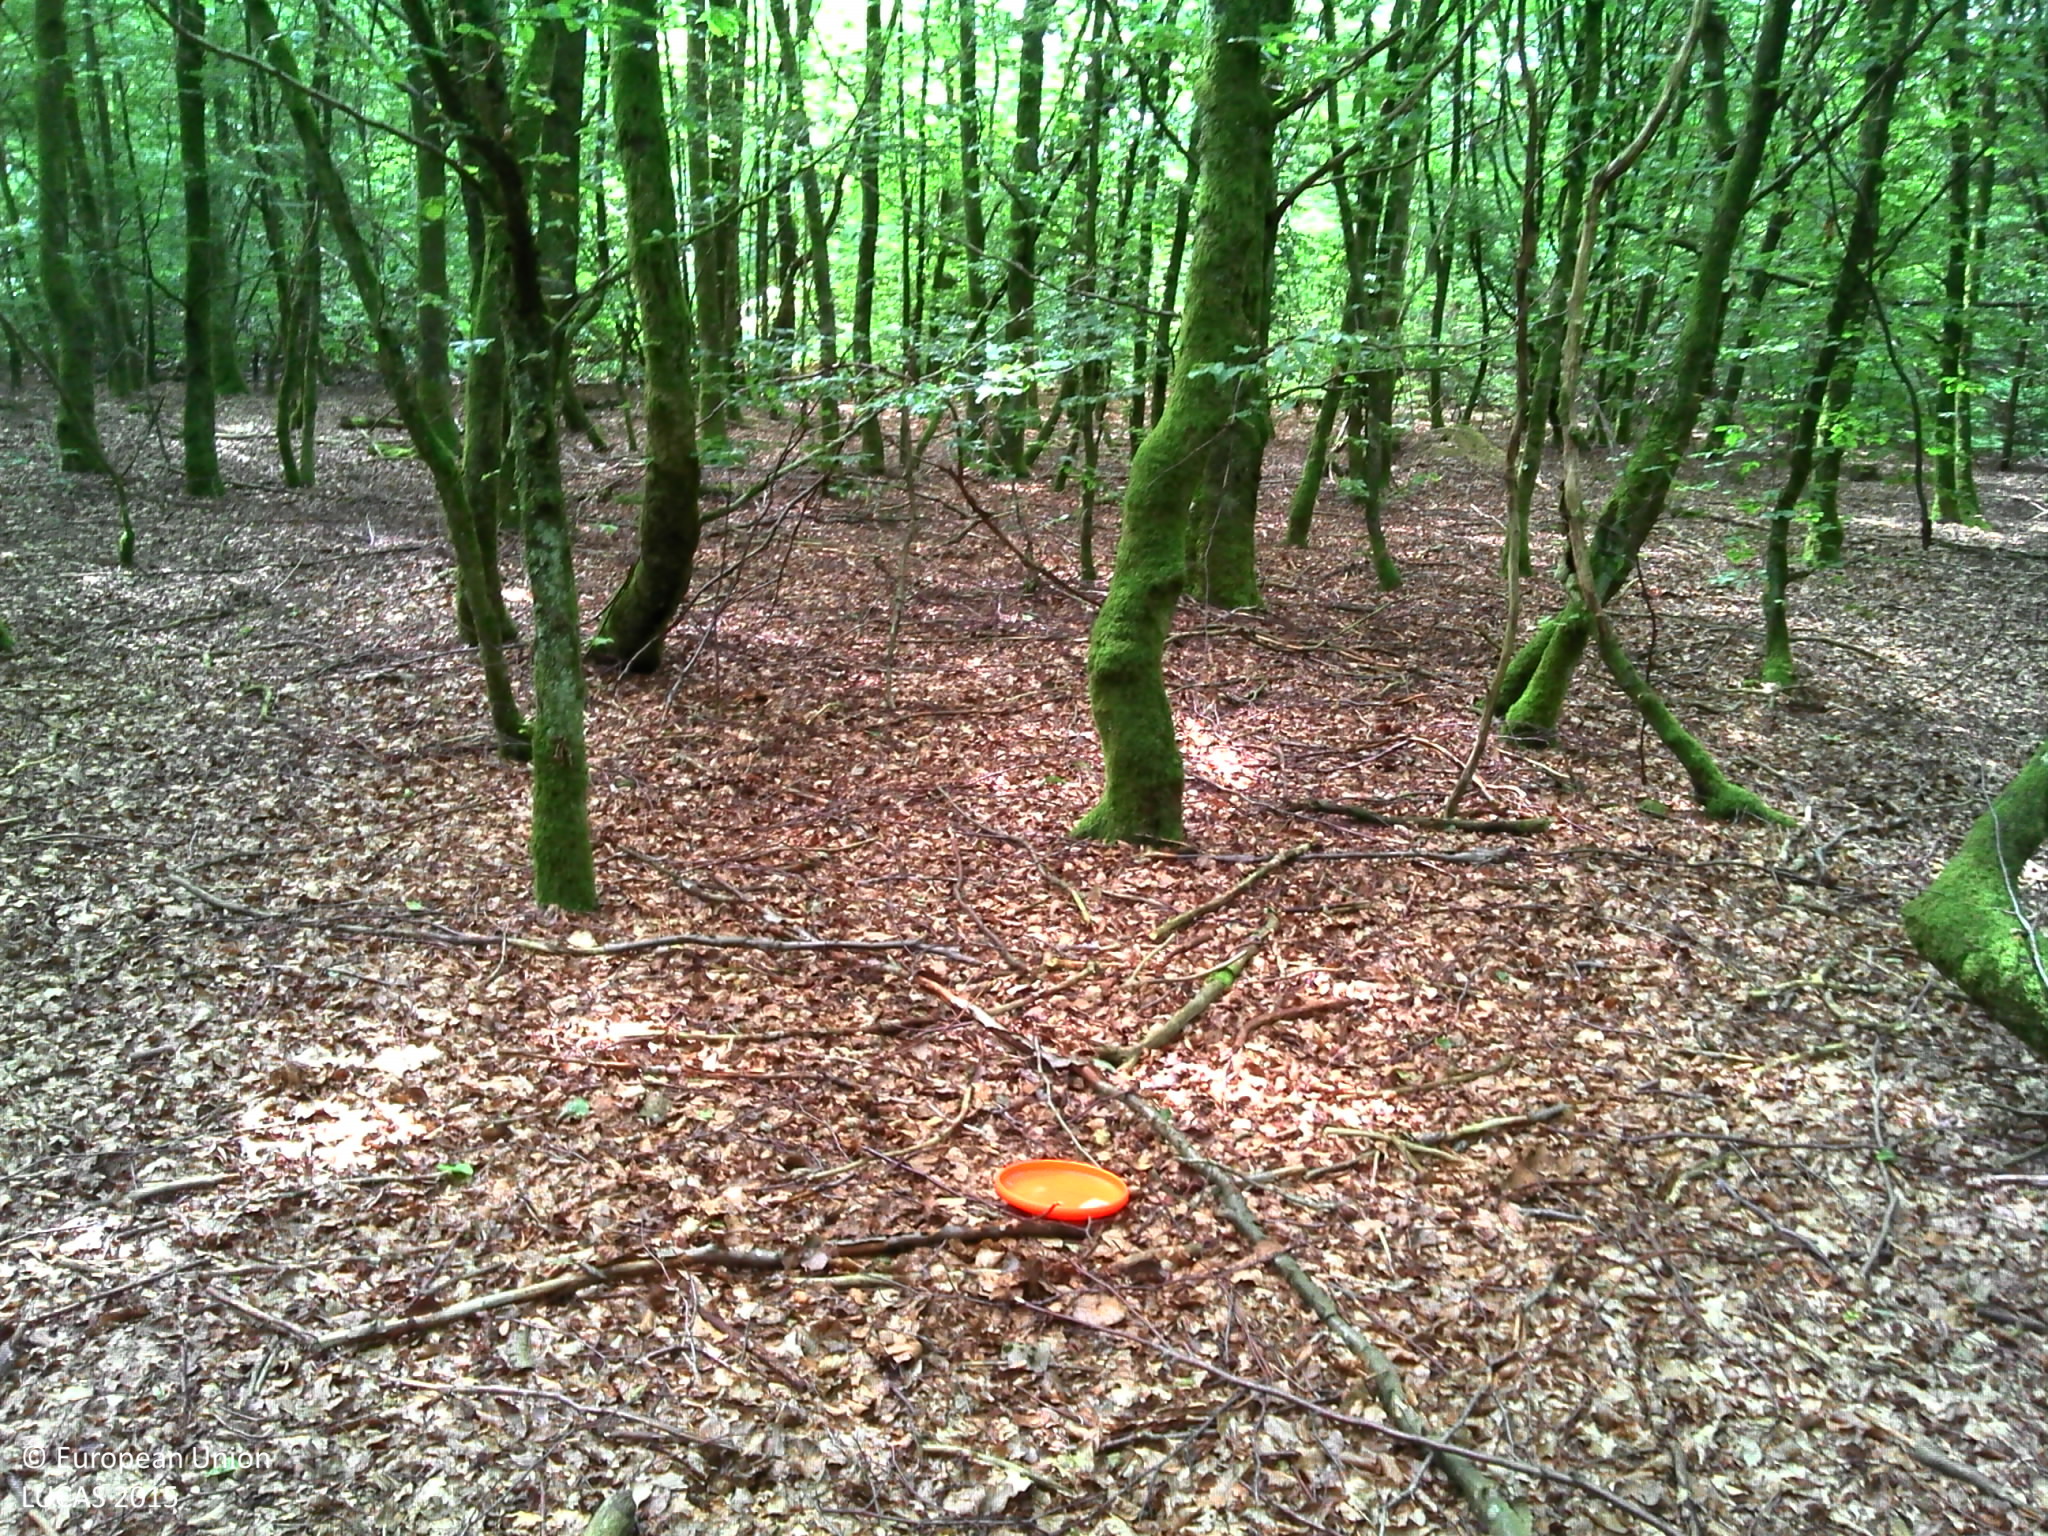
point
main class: Woodland
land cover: Broadleaved woodland
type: beech forest
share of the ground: > 75 %
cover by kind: broadleaved forest trees 100 %
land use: Forestry
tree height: > 5 m
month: July
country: BE
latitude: 49.7381
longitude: 5.5722
